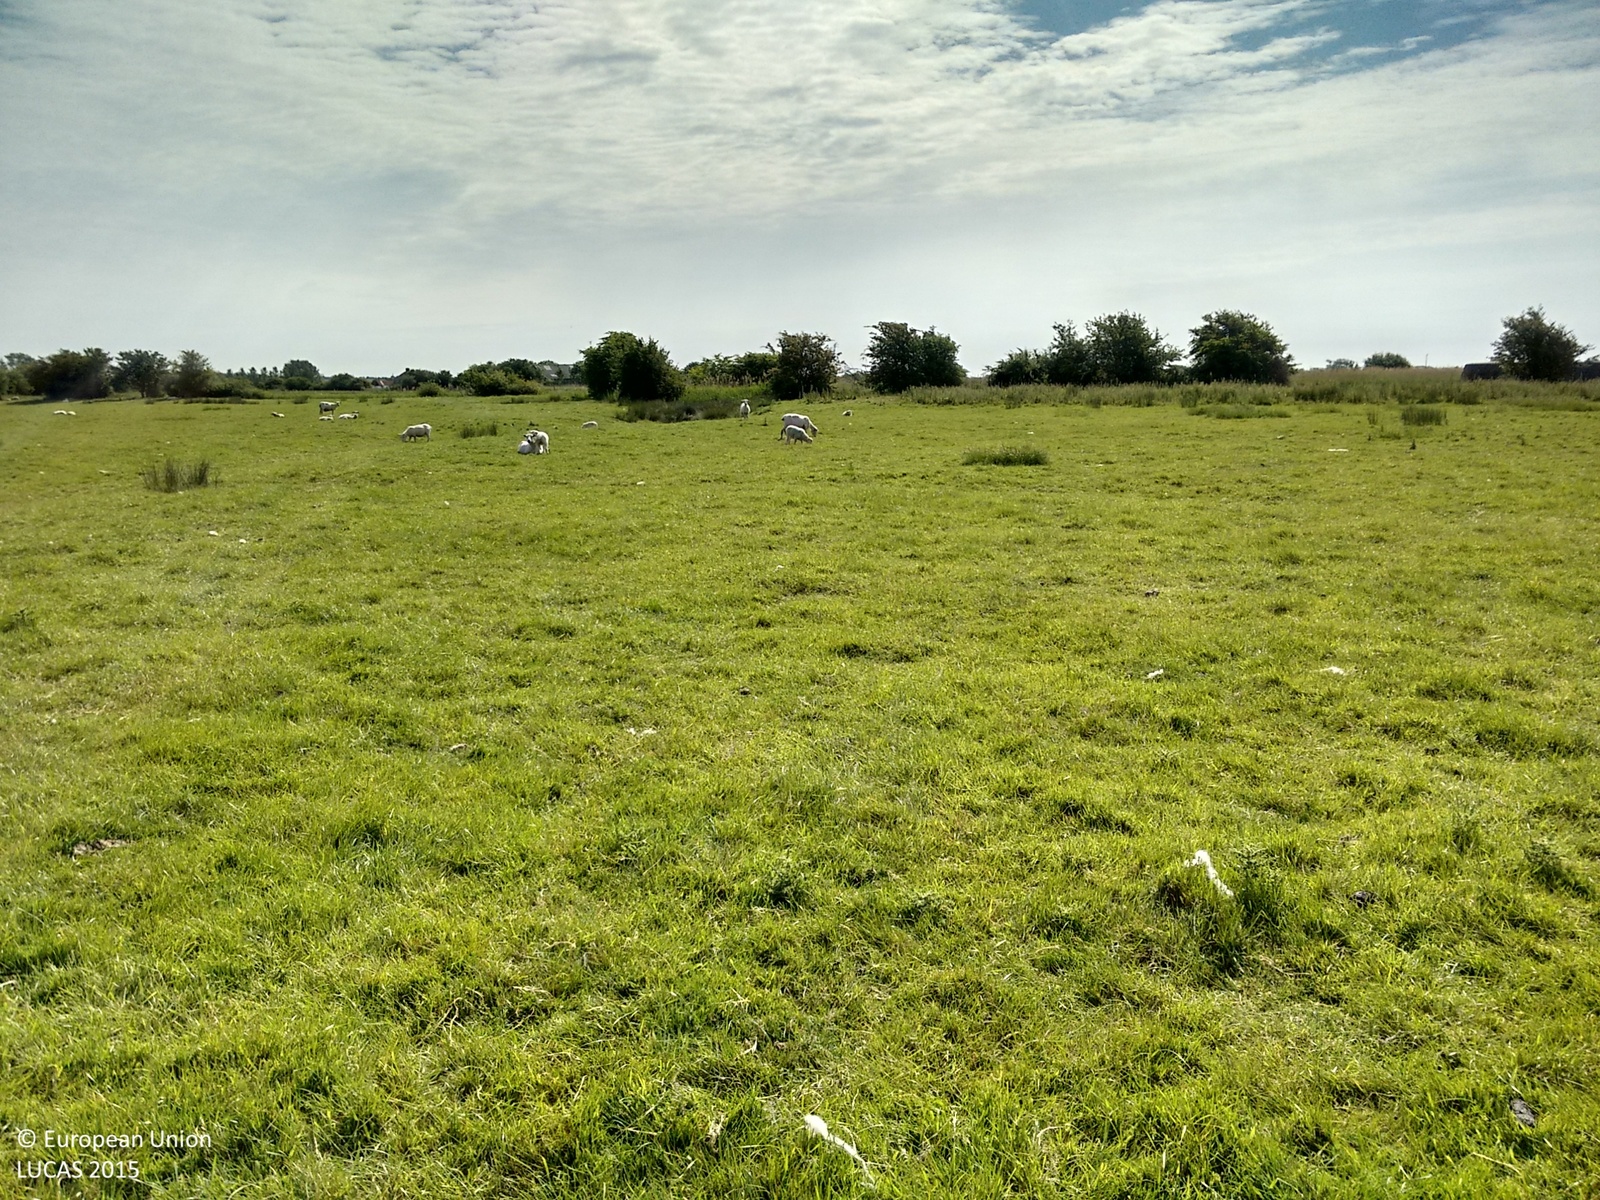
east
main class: Grassland
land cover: Grassland without tree/shrub cover
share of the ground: > 75 %
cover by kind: herbaceous plants 100 %
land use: Agriculture (excluding fallow land and kitchen gardens)
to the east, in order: Grassland without tree/shrub cover; Abandoned hedges; Rivers and streams; Grassland without tree/shrub cover; Rivers and streams; Grassland without tree/shrub cover; Rivers and streams; Grassland without tree/shrub cover
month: June
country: GB
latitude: 50.8407
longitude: 0.3281
